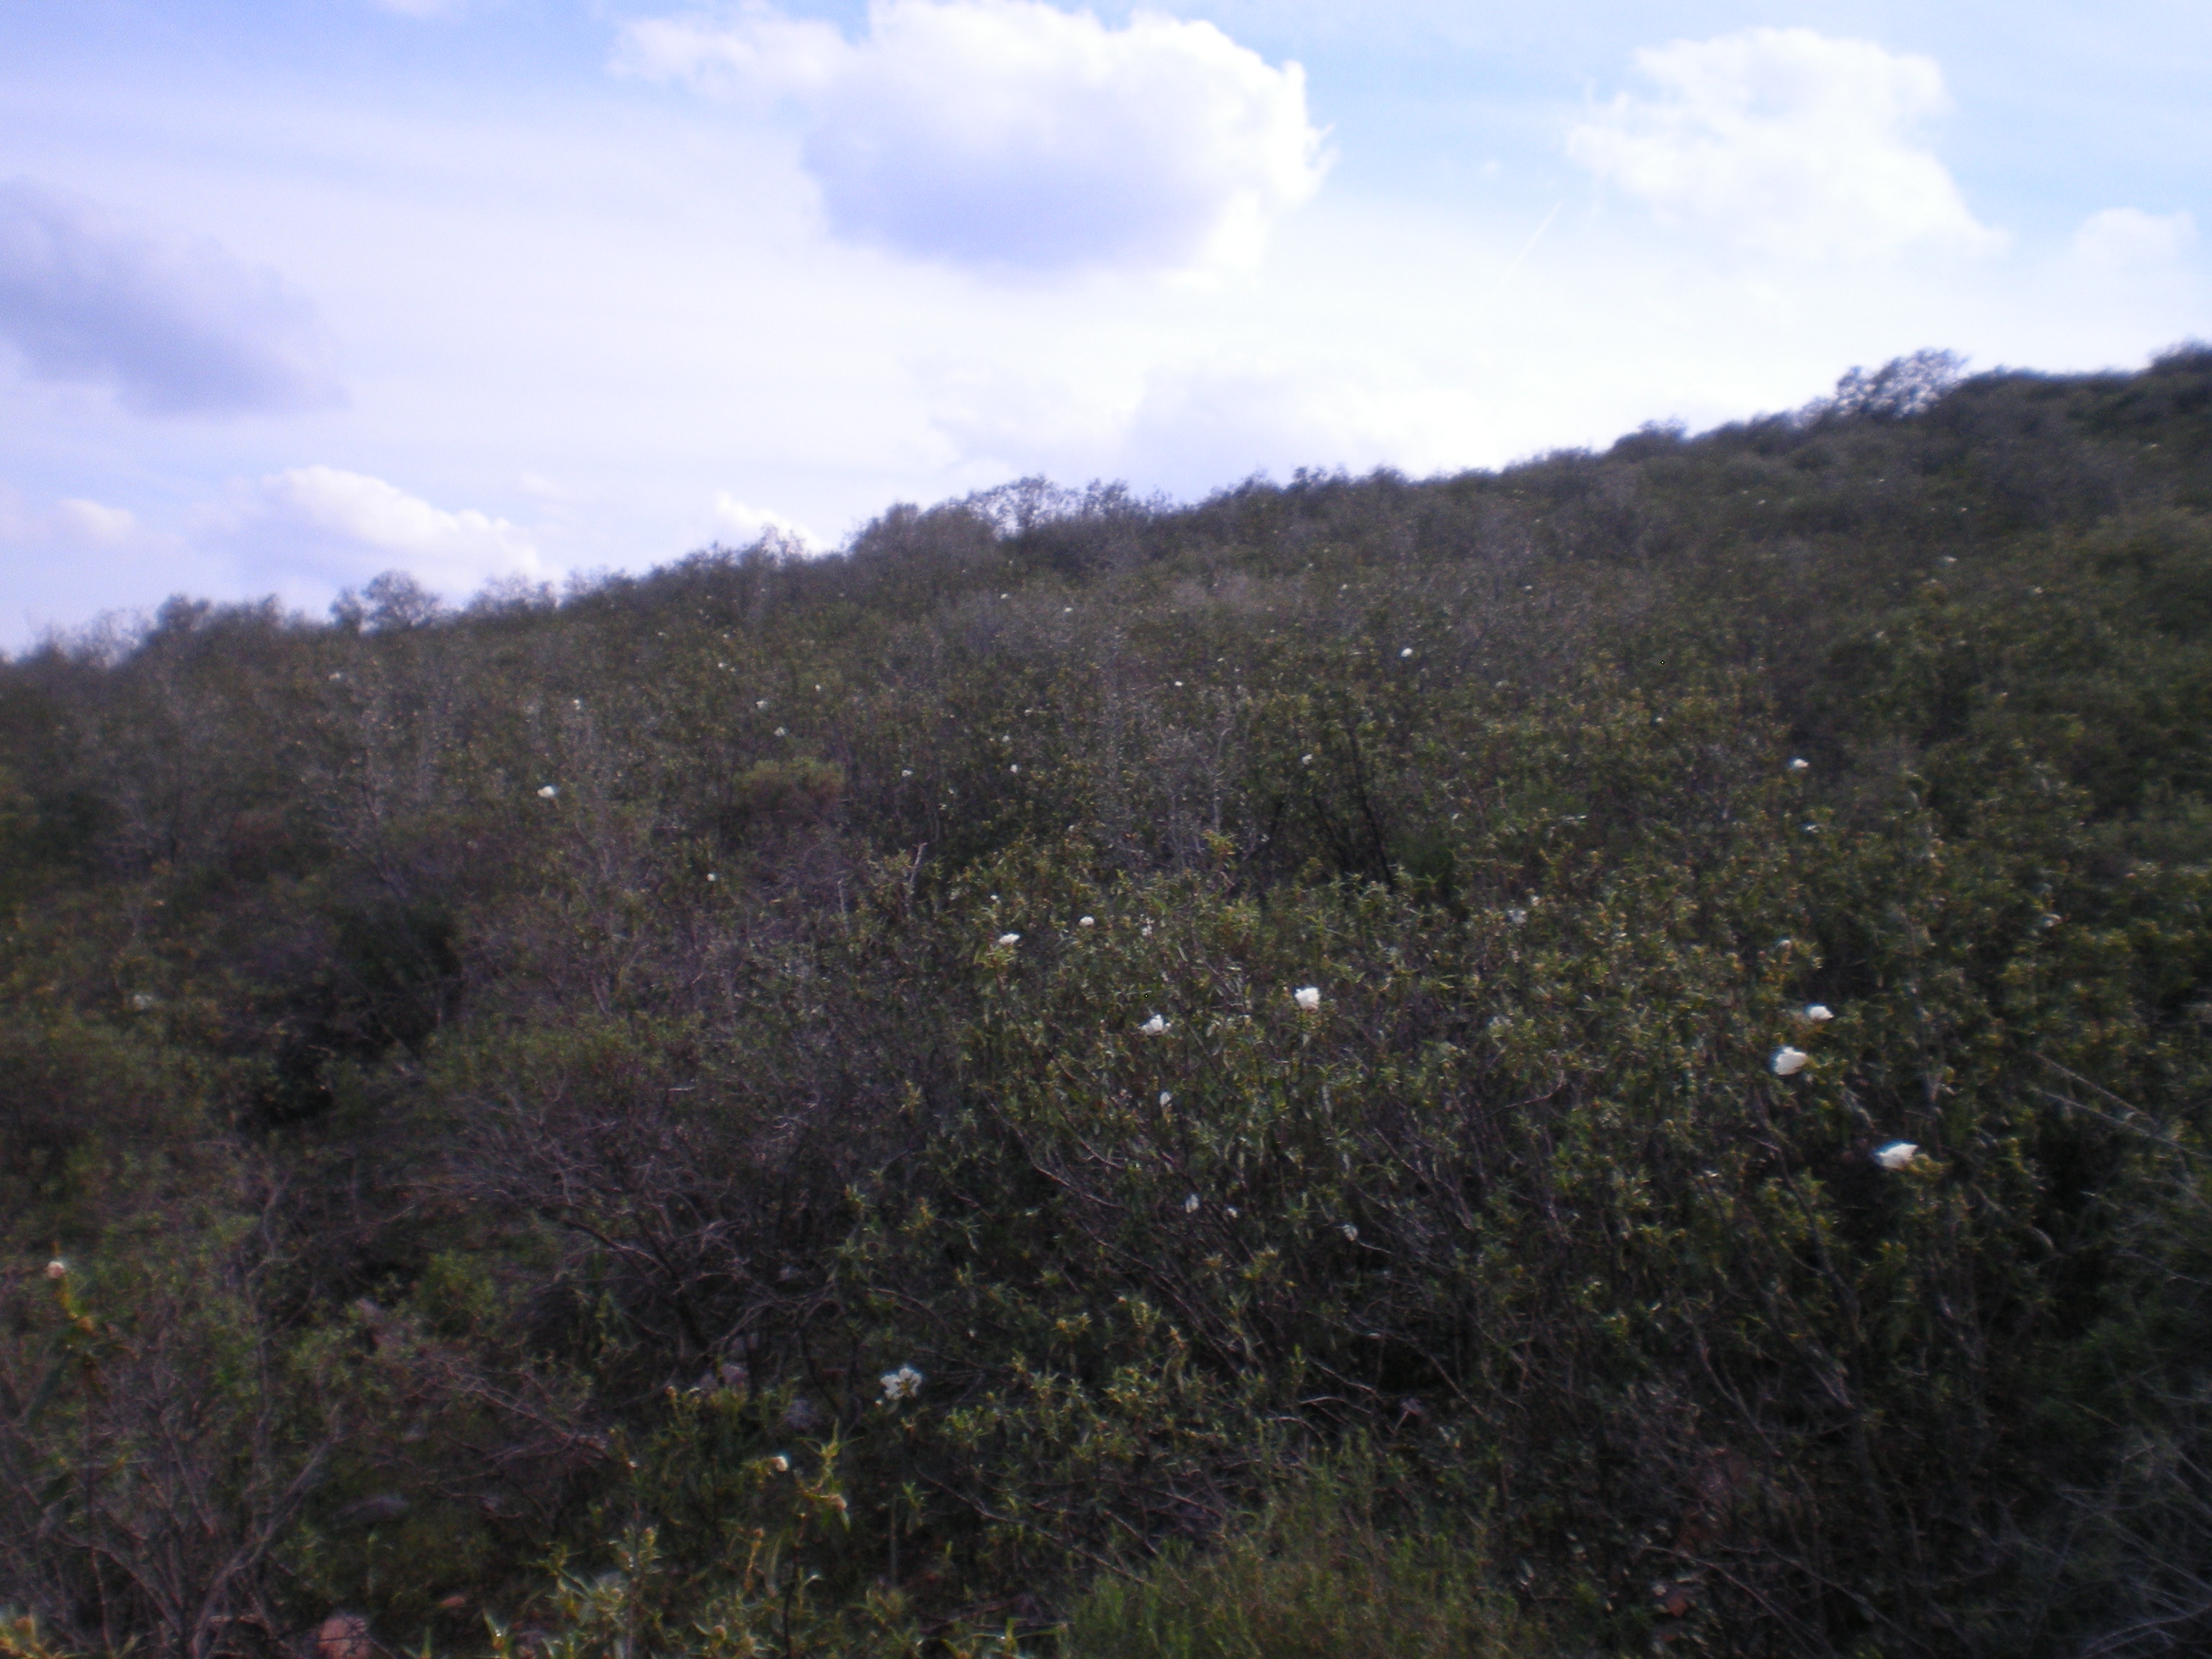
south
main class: Shrubland
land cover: Shrubland with sparse tree cover
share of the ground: > 75 %
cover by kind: shrubs 80 %, herbaceous plants 10 %, broadleaved forest trees 5 %, unconsolidated bare surface 5 %
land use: Other primary production
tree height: < 5 m
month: April
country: ES
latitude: 38.8846
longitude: -3.5367
